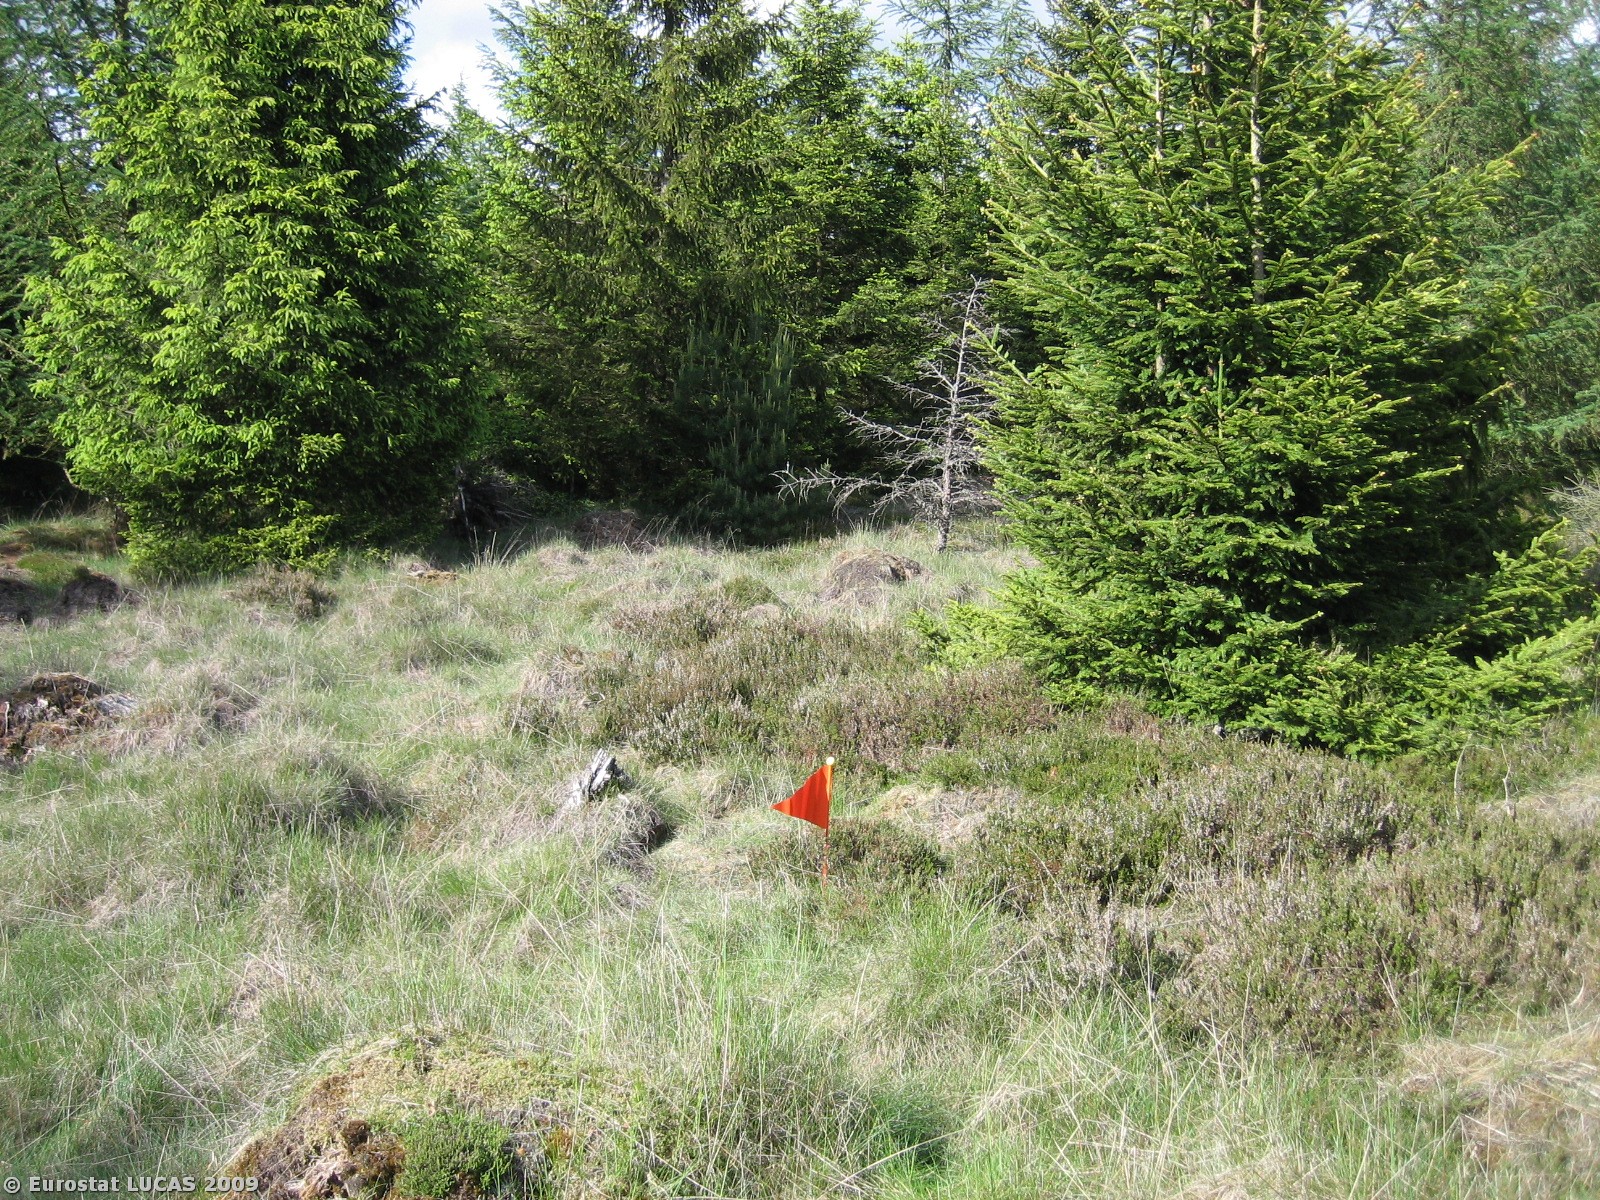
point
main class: Shrubland
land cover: Shrubland with sparse tree cover
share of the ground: > 75 %
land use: Forestry
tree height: > 5 m
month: May
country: DK
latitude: 56.0574
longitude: 8.9253
